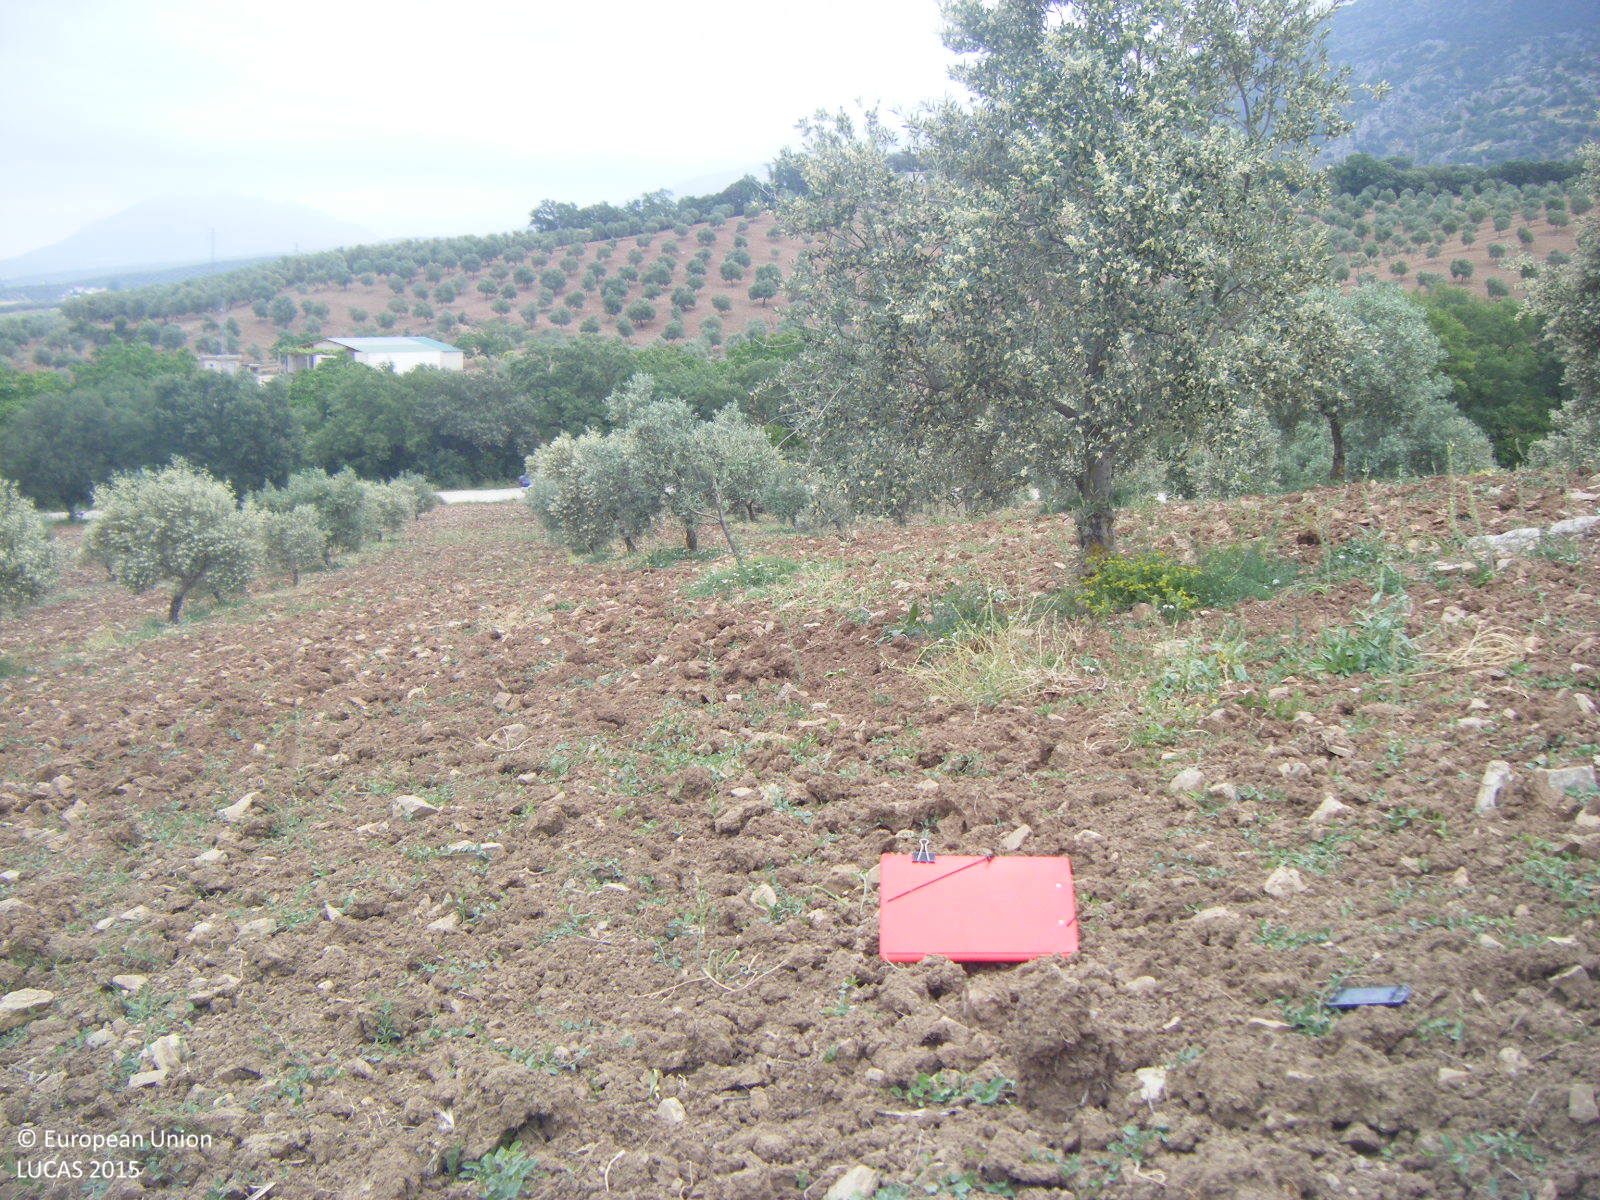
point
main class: Cropland
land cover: Olive groves
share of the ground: 10 - 25 %
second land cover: Other bare soil
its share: > 75 %
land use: Agriculture (excluding fallow land and kitchen gardens)
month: May
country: ES
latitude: 36.9753
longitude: -4.4066
